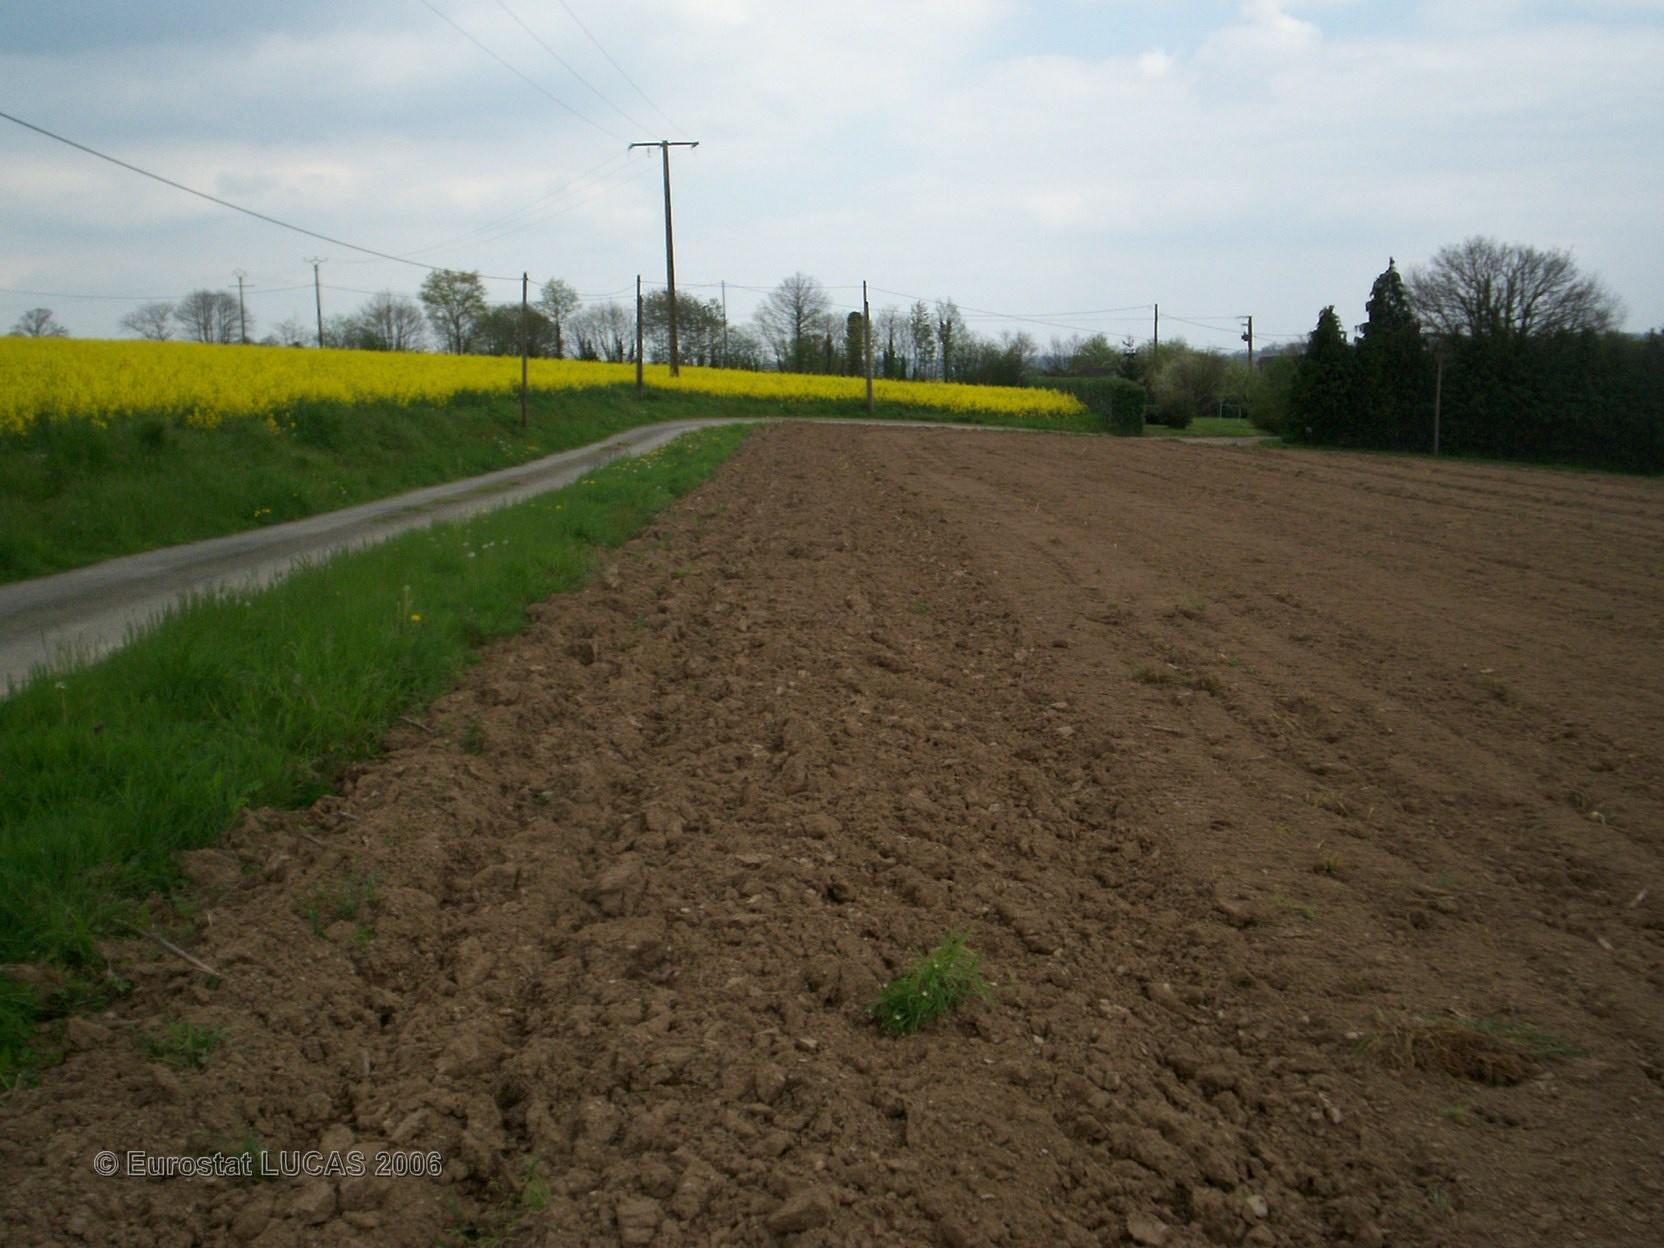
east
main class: Cropland
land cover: Maize
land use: Agriculture (excluding fallow land and kitchen gardens)
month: June
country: FR
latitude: 48.1088
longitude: -1.3388
